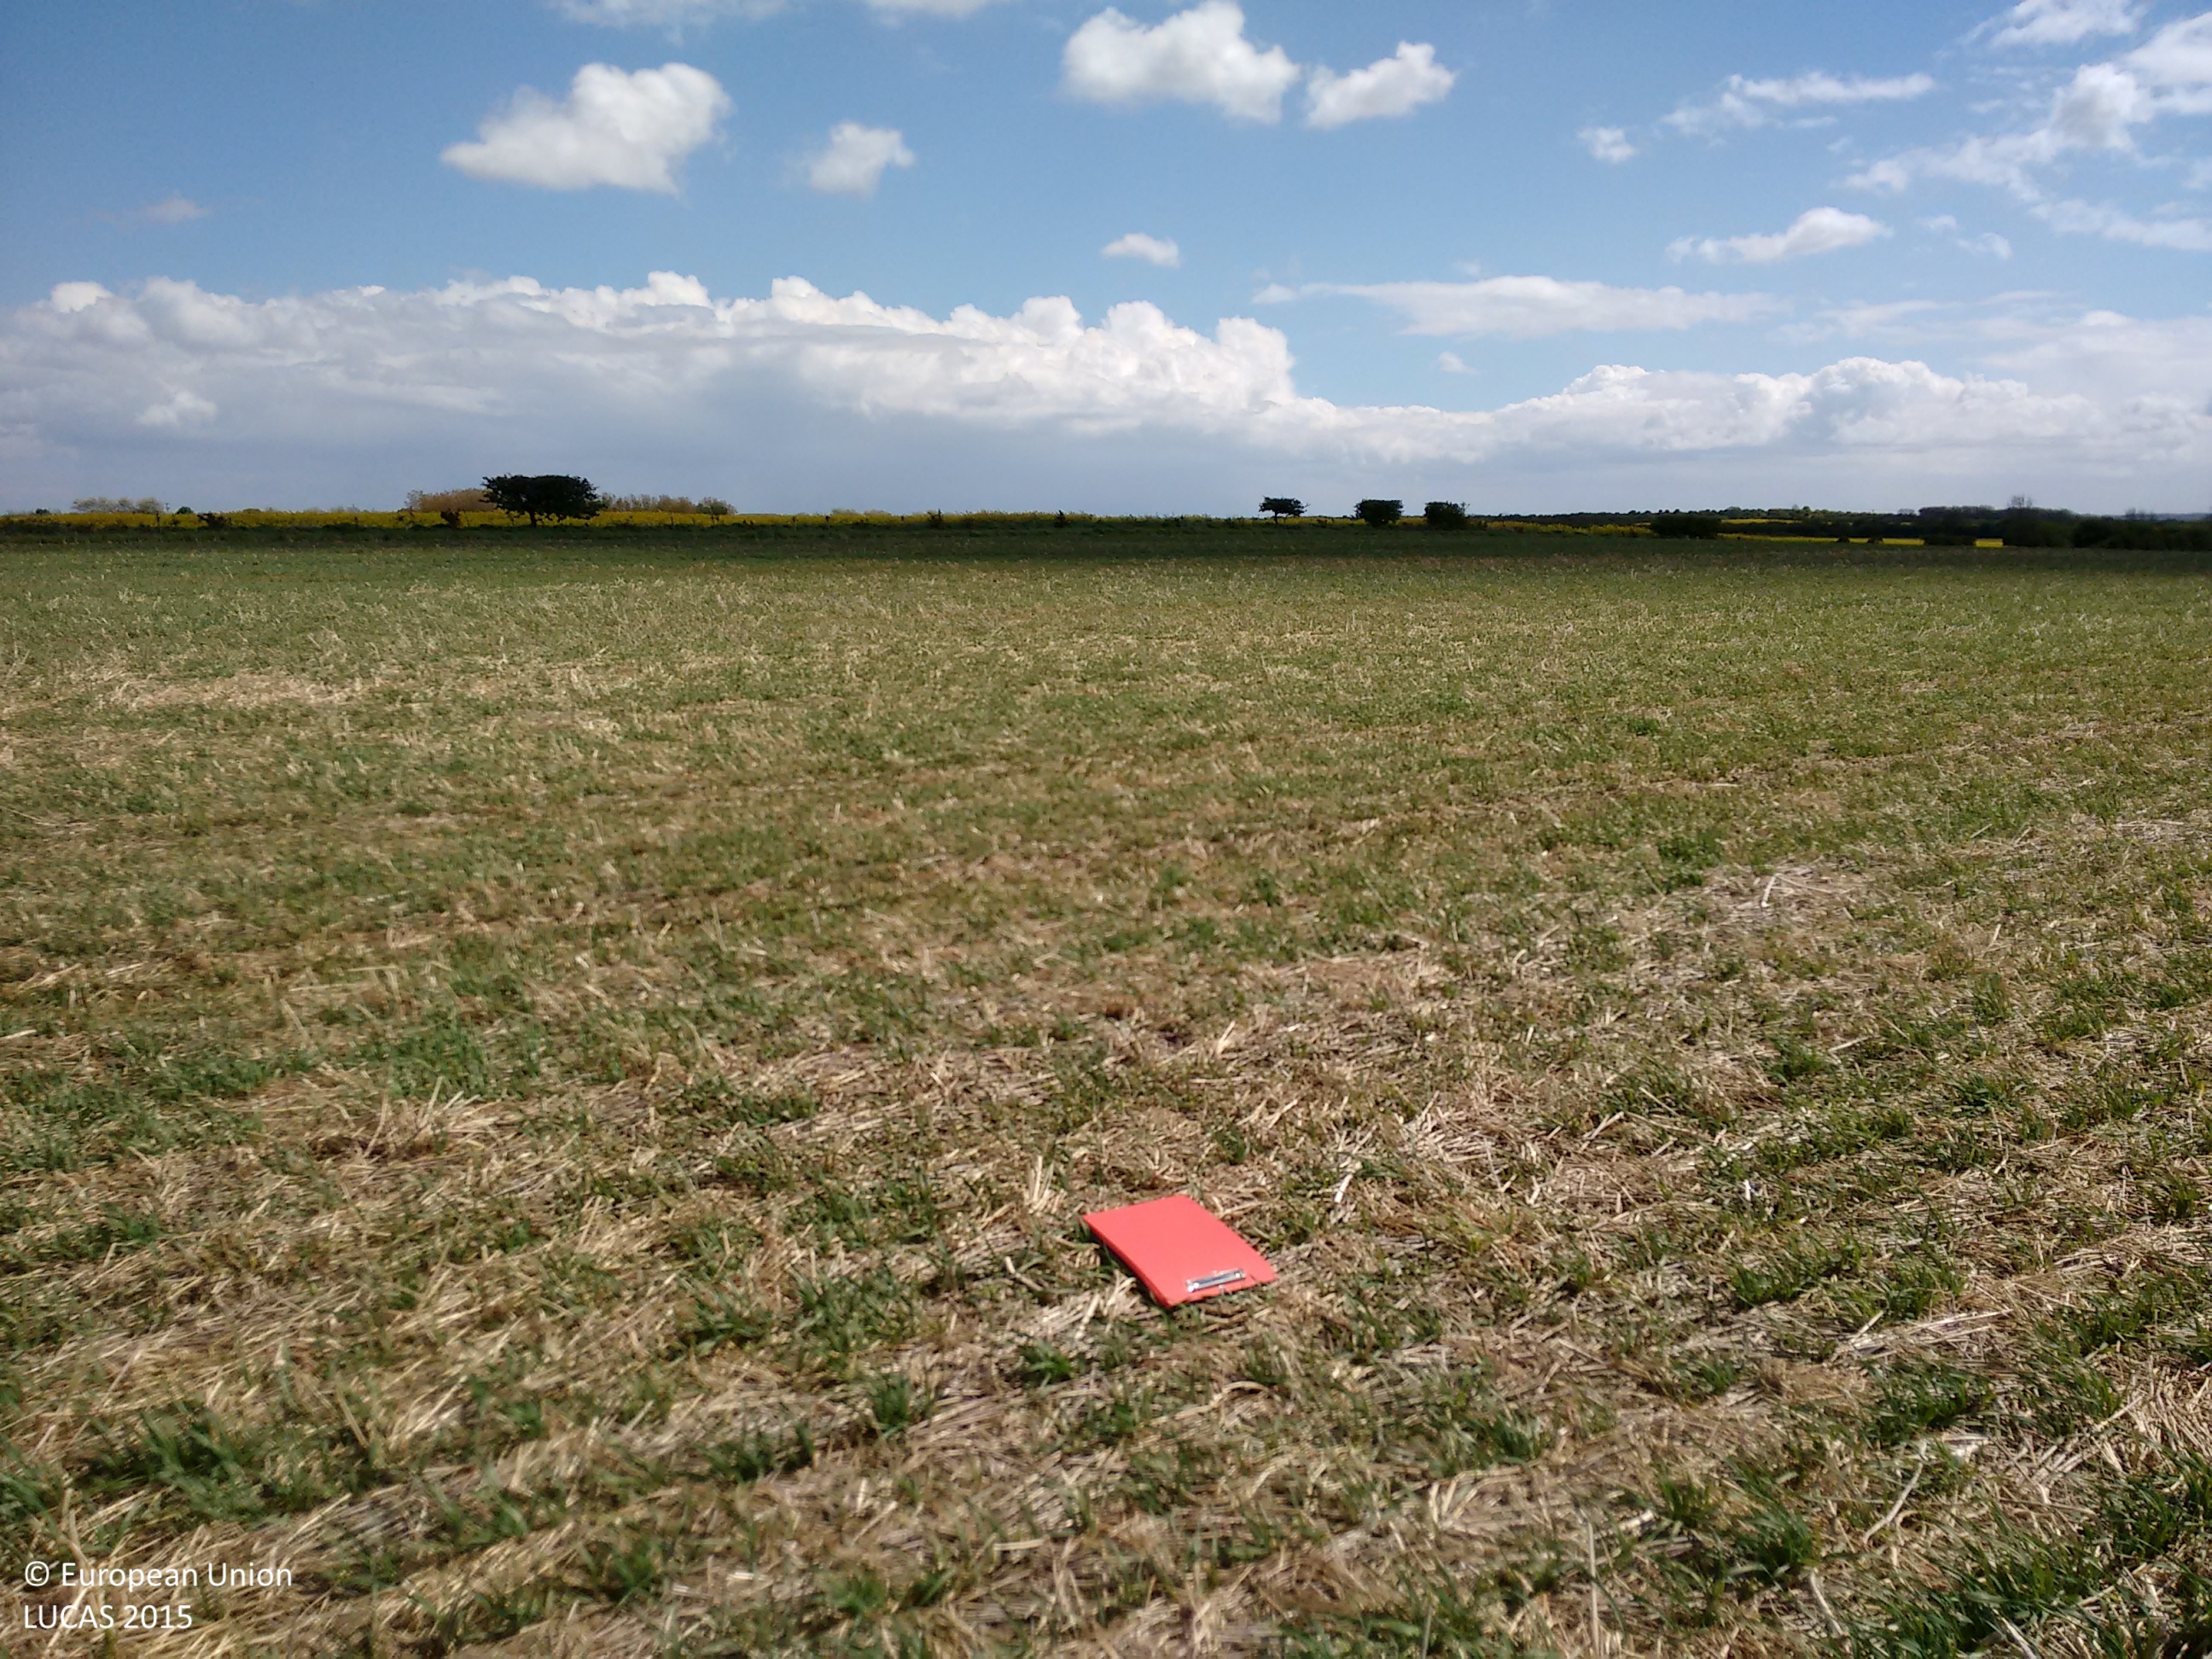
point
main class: Cropland
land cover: Barley
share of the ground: 25 - 50 %
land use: Agriculture (excluding fallow land and kitchen gardens)
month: May
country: GB
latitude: 53.8630
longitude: -0.1446
